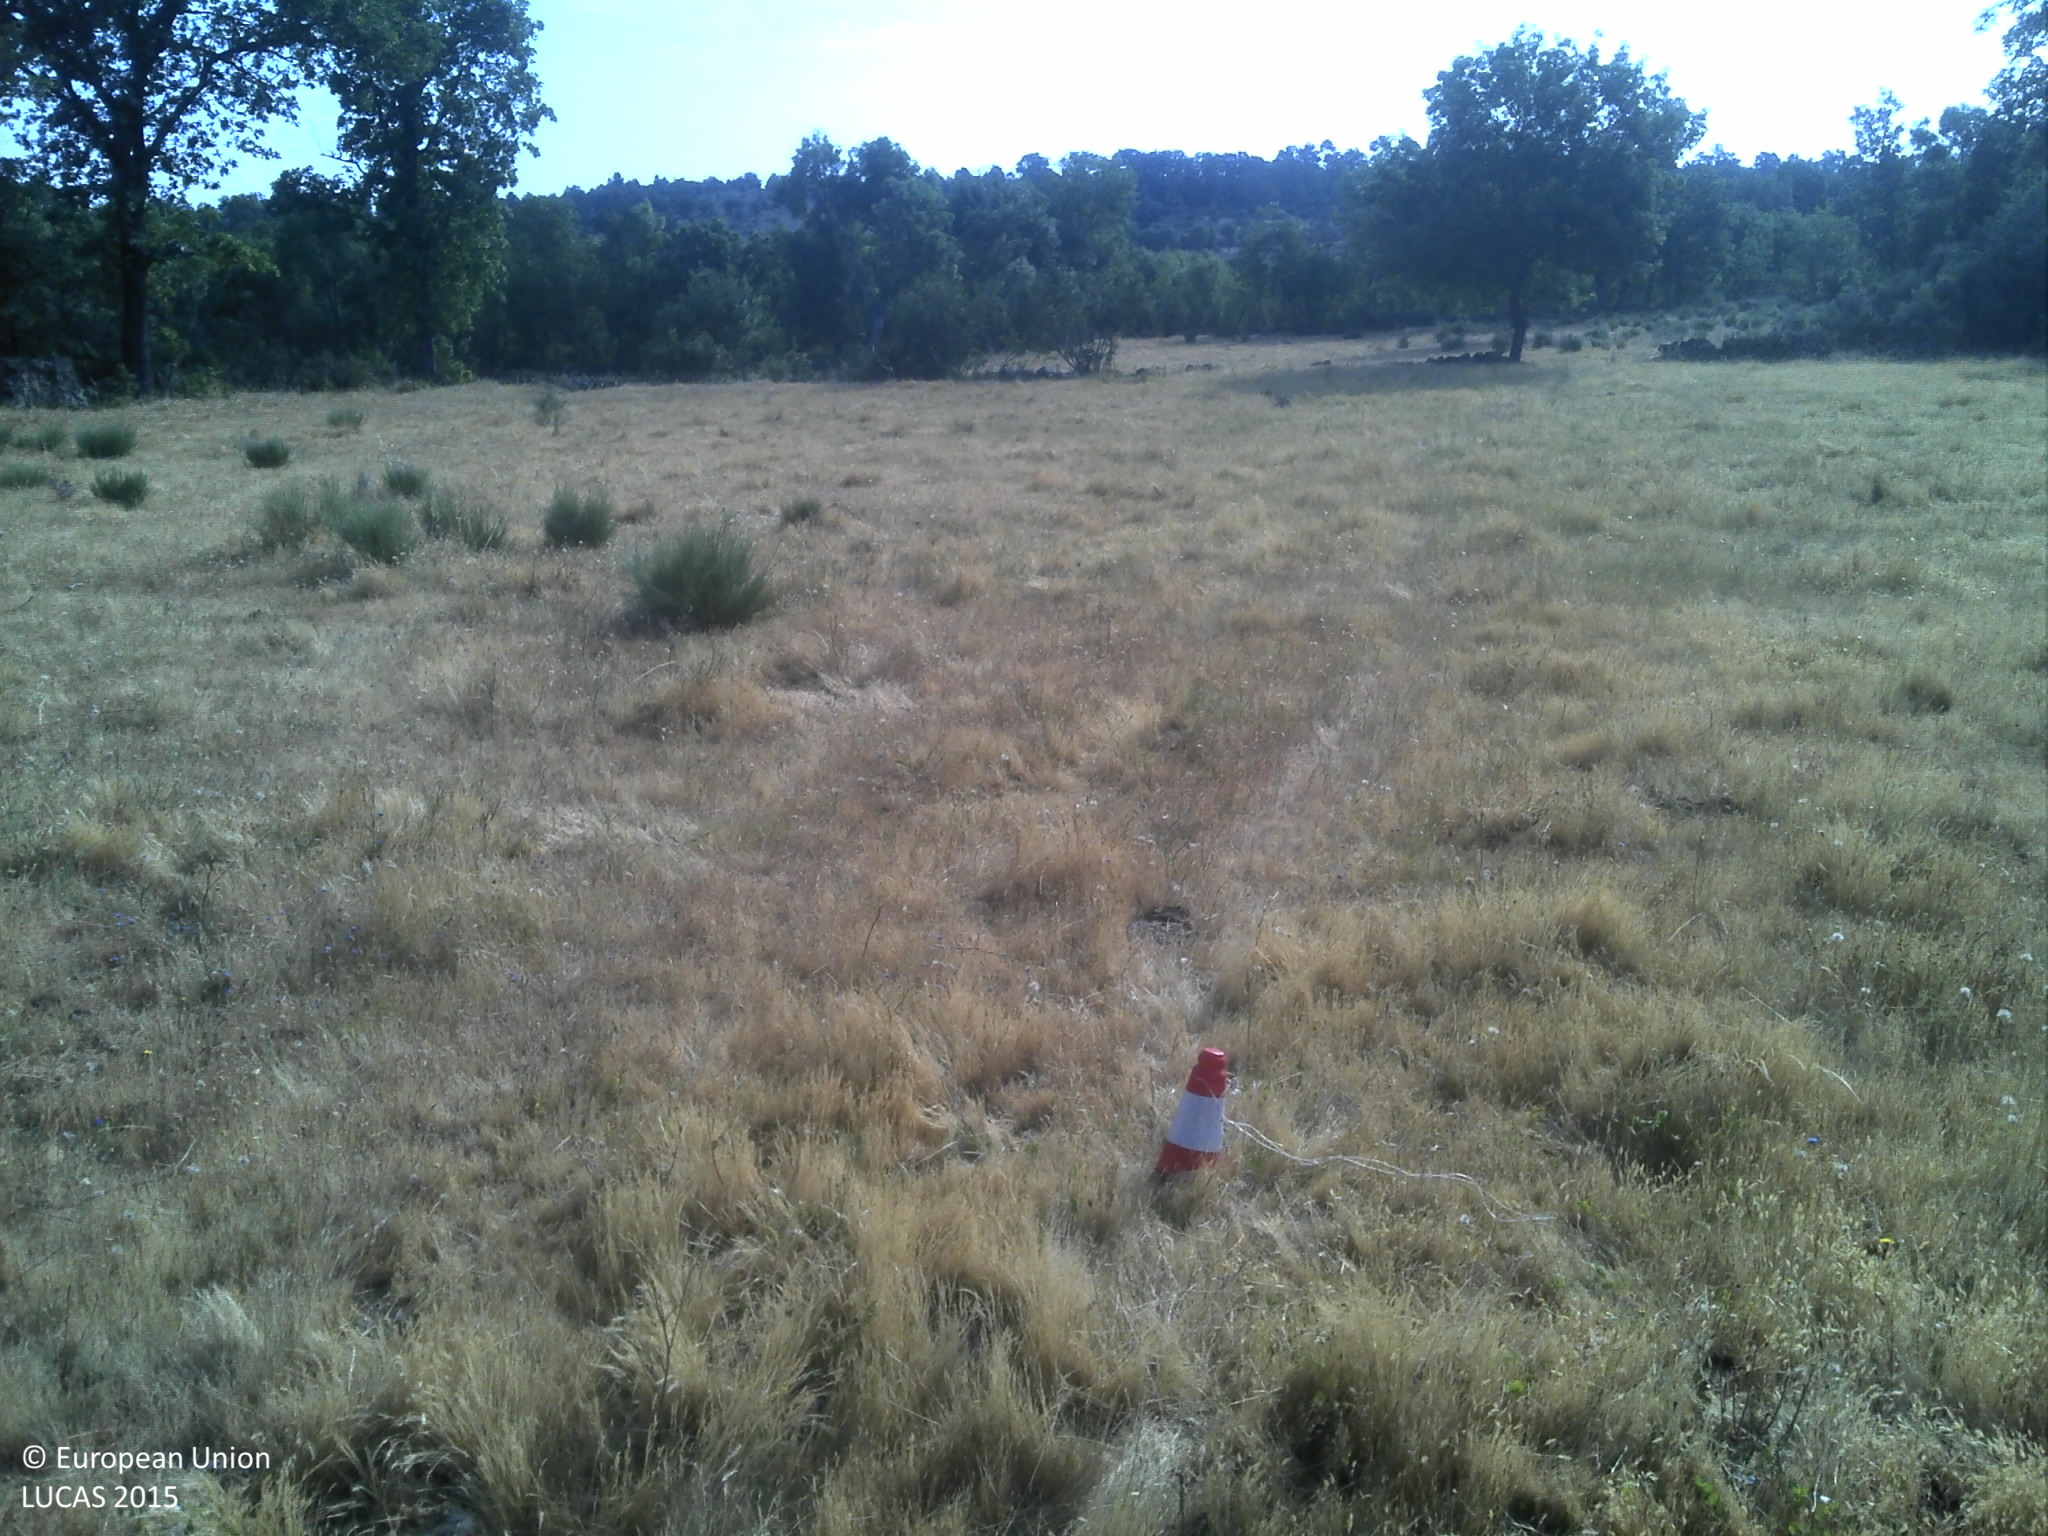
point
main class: Grassland
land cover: Grassland without tree/shrub cover
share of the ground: 50 - 75 %
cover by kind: herbaceous plants 75 %, unconsolidated bare surface 25 %
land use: Agriculture (excluding fallow land and kitchen gardens)
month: June
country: PT
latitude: 40.4149
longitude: -6.9848
